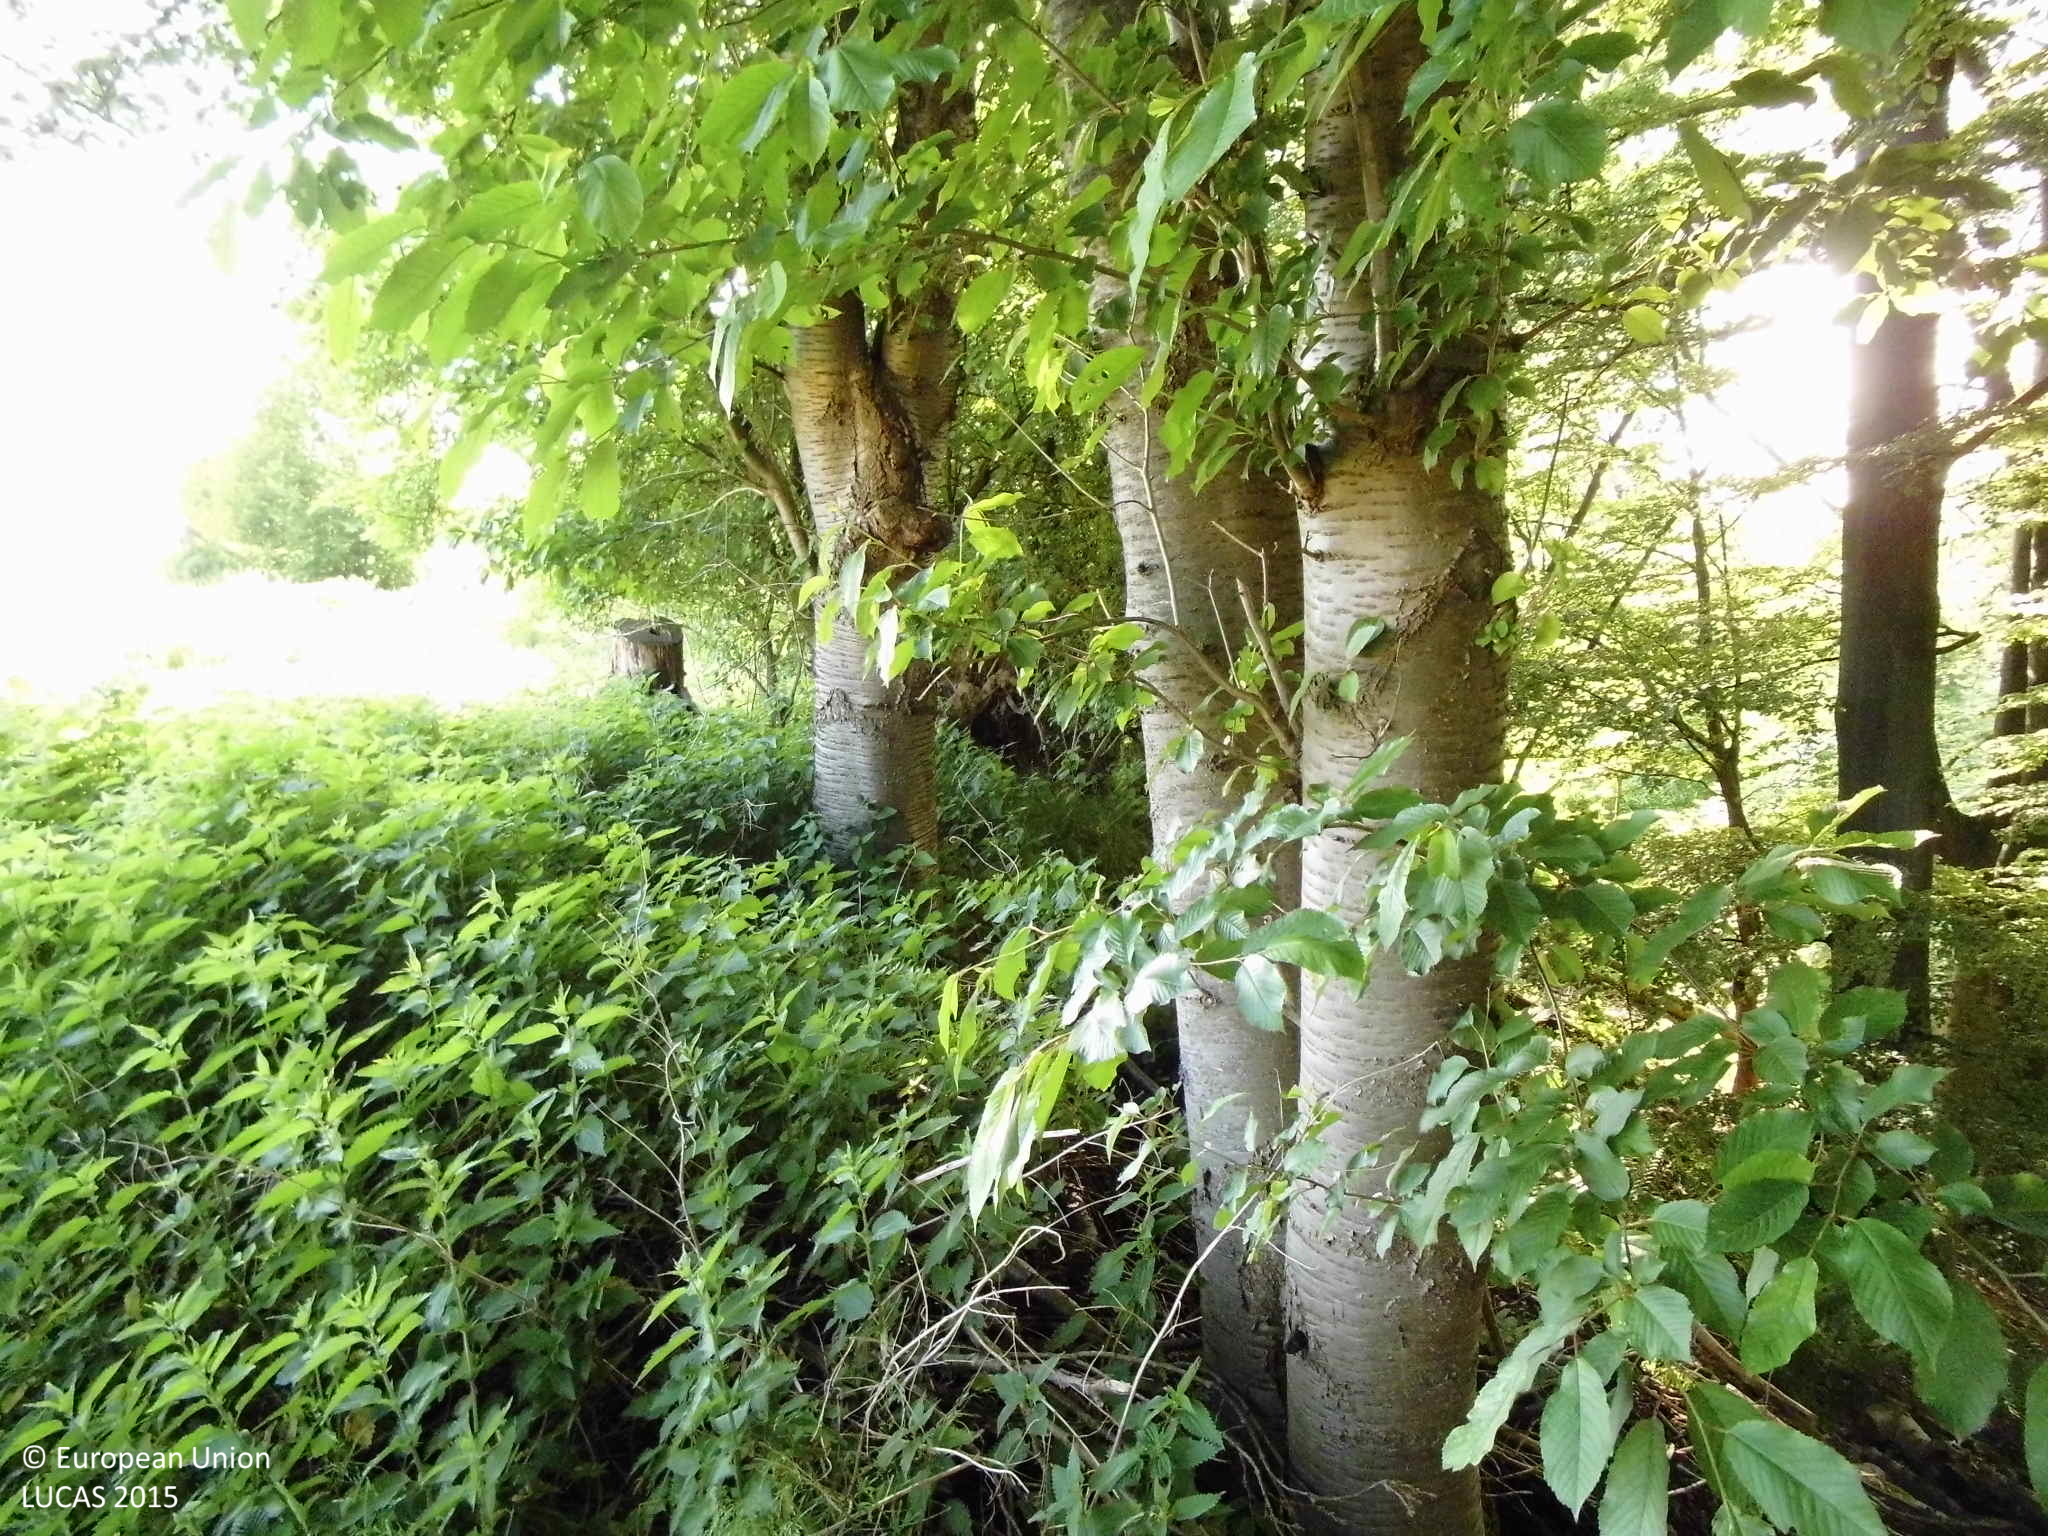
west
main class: Woodland
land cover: Broadleaved woodland
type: mesophytic deciduous forest
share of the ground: > 75 %
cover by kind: broadleaved forest trees 75 %, coniferous forest trees 10 %, shrubs 5 %, herbaceous plants 5 %, unconsolidated bare surface 5 %
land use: Forestry
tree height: > 5 m
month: May
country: DE
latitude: 50.7689
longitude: 7.5189
